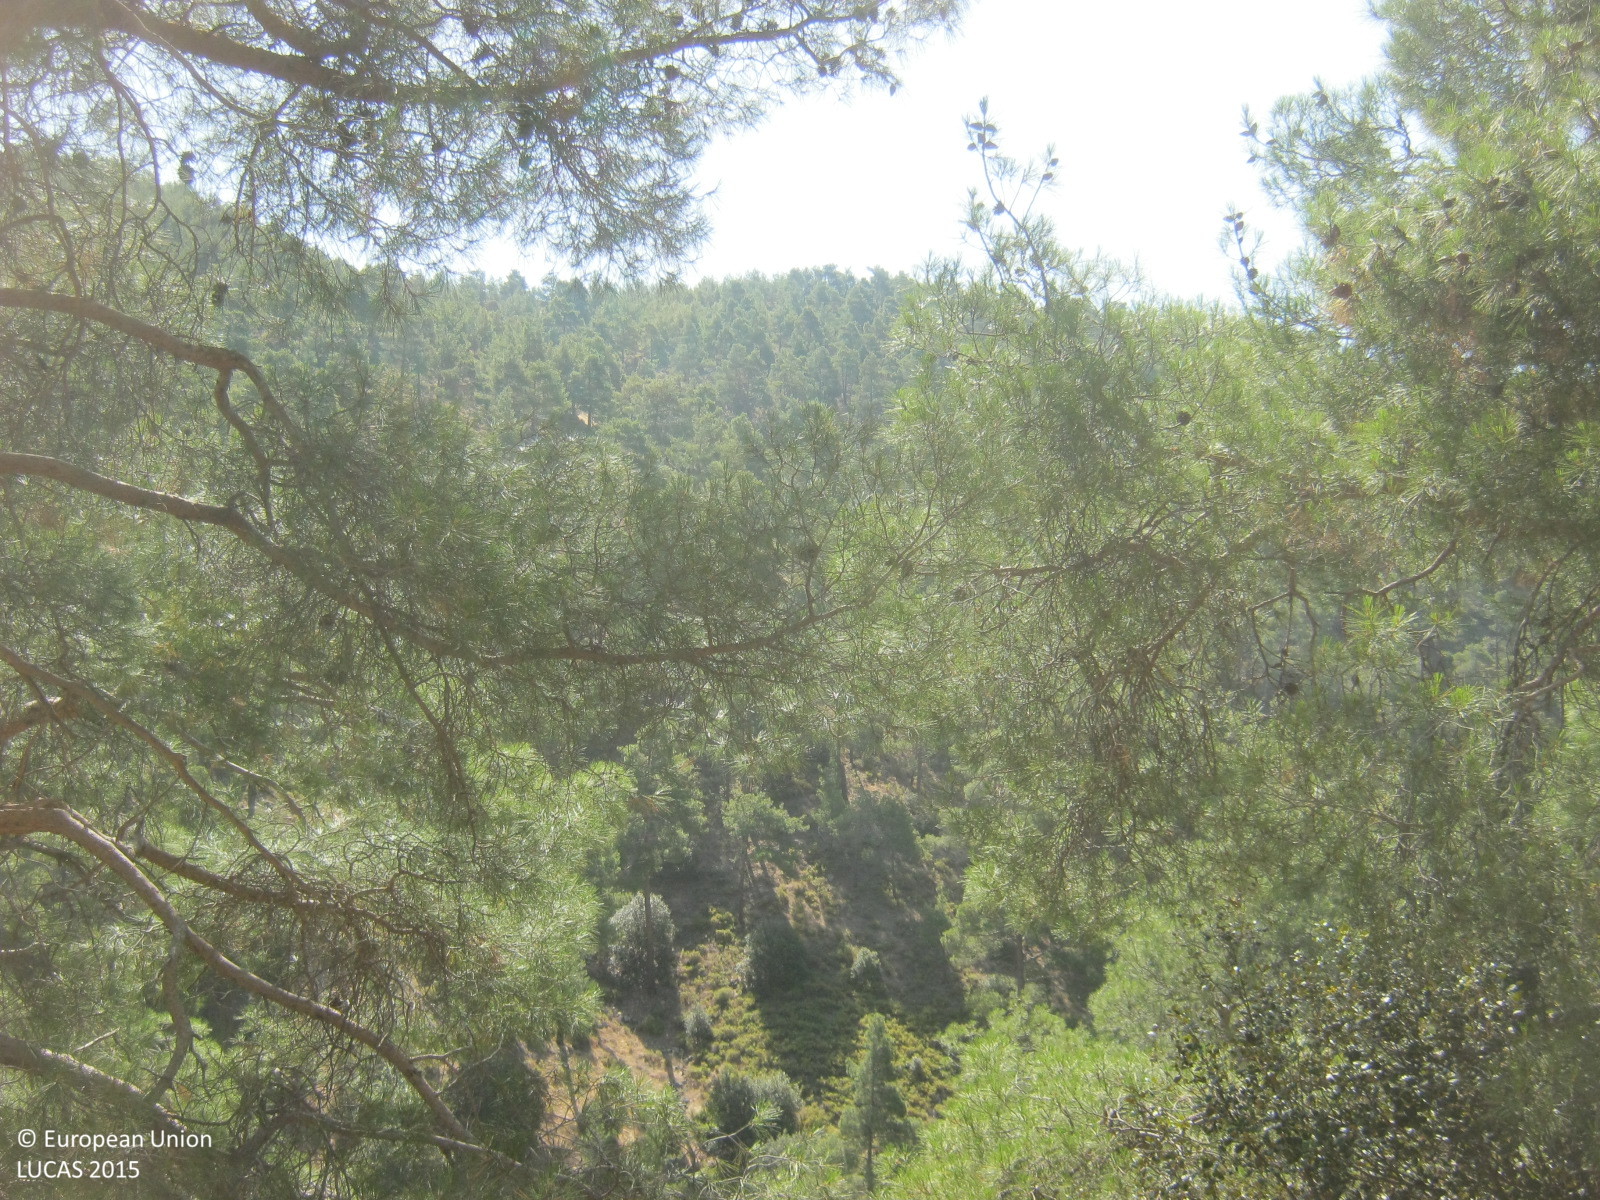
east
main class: Woodland
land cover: Pine dominated mixed woodland
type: coniferous forest of the mediterranean region
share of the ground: 25 - 50 %
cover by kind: coniferous forest trees 40 %, unconsolidated bare surface 20 %, broadleaved forest trees 15 %, shrubs 15 %, herbaceous plants 10 %
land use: Forestry
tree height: > 5 m
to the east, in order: Pine dominated mixed woodland; Paved roads, cycling and walking lanes; Pine dominated mixed woodland; Rivers and streams; Pine dominated mixed woodland
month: June
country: CY
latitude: 35.0237
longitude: 32.9815
